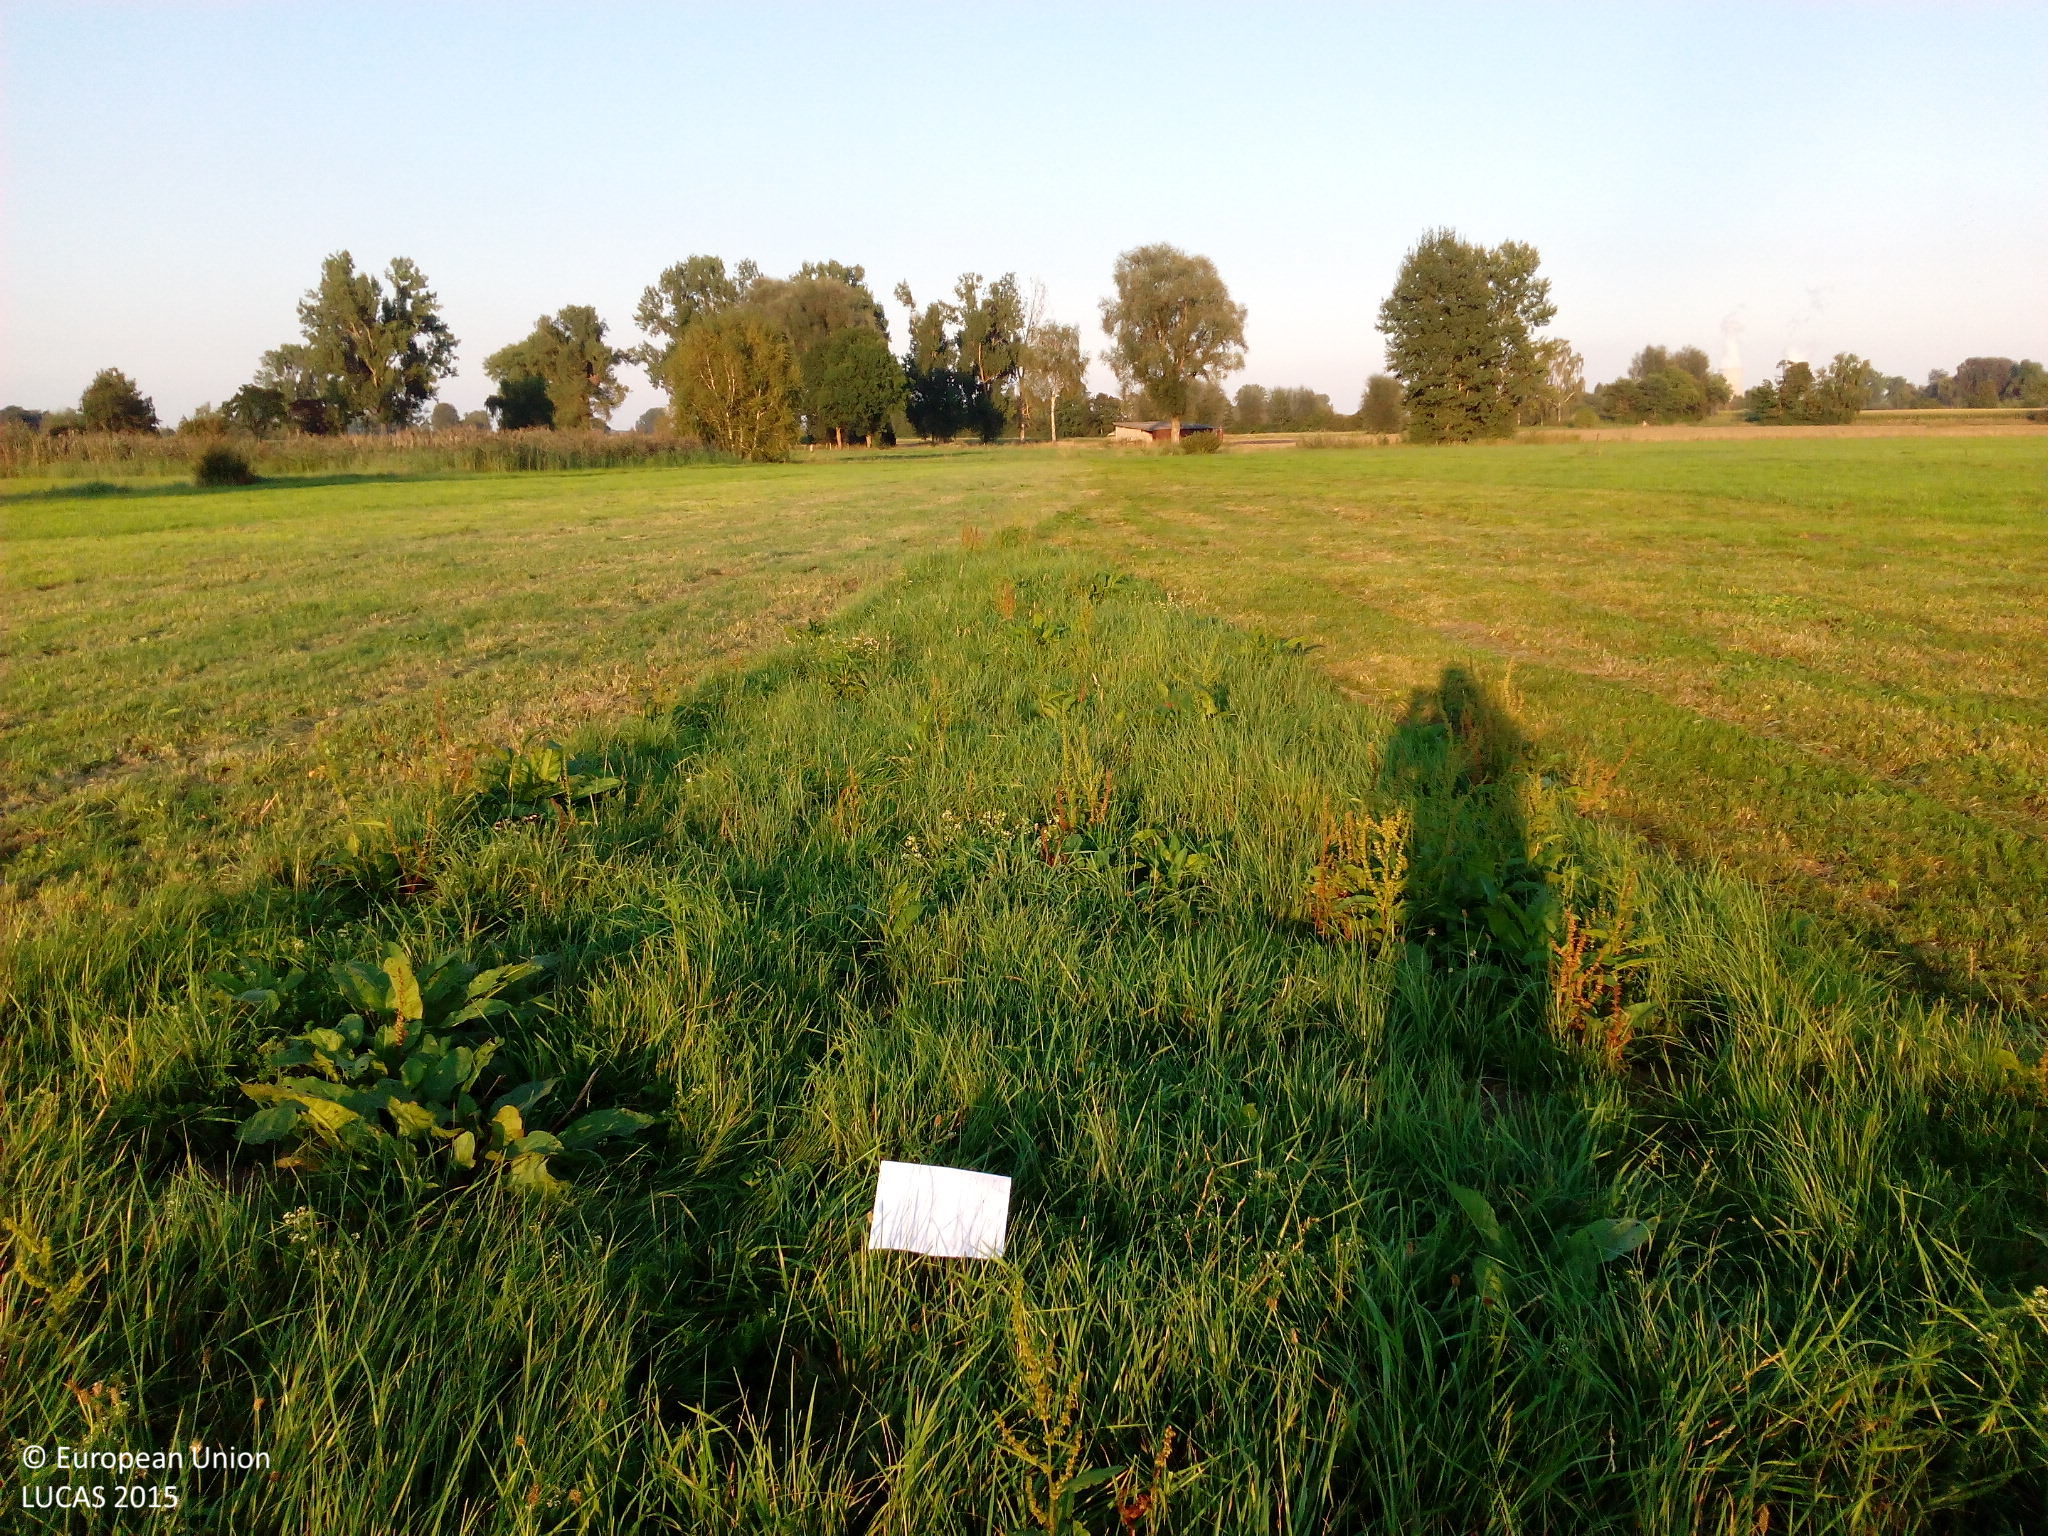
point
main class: Grassland
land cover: Grassland without tree/shrub cover
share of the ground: > 75 %
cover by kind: herbaceous plants 100 %
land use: Agriculture (excluding fallow land and kitchen gardens)
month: August
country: DE
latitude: 48.5290
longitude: 10.3113
